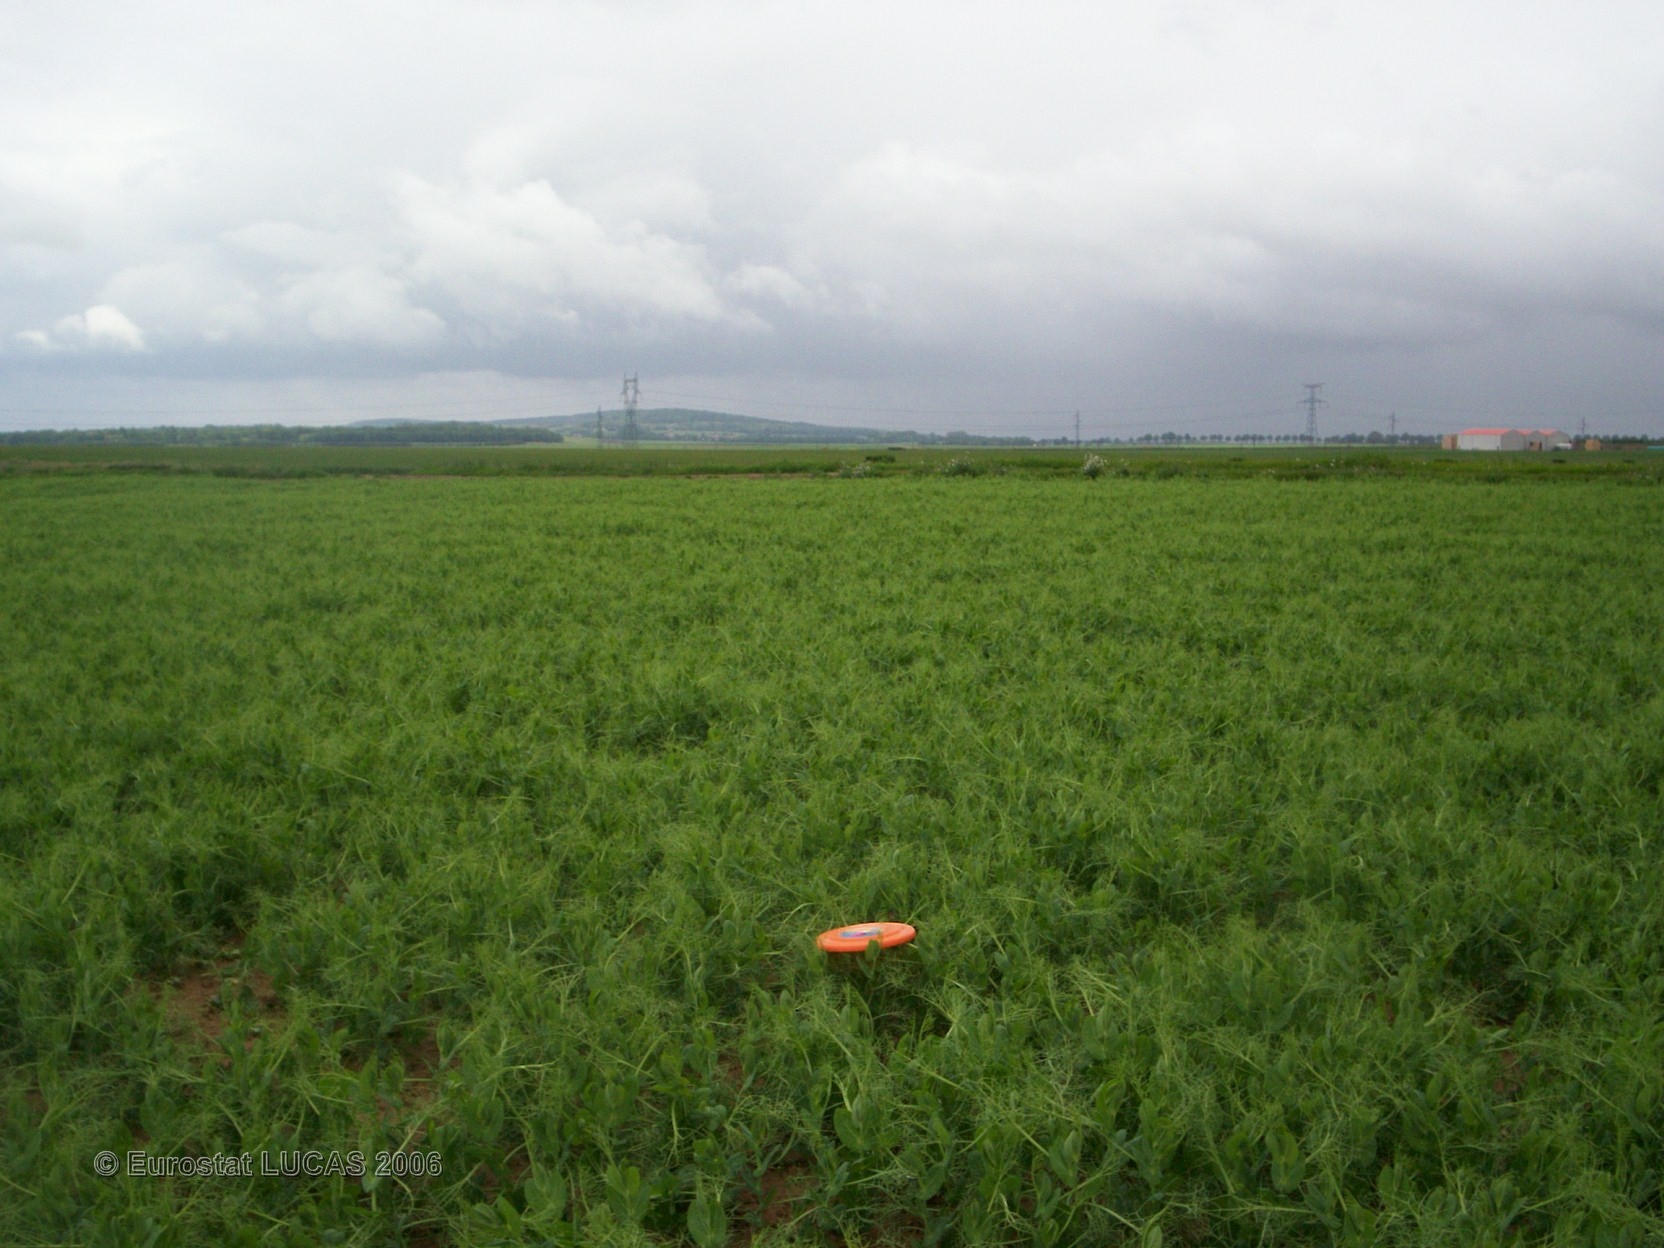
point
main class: Cropland
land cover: Dry pulses
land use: Agriculture (excluding fallow land and kitchen gardens)
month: May
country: FR
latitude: 49.2670
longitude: 2.7472
